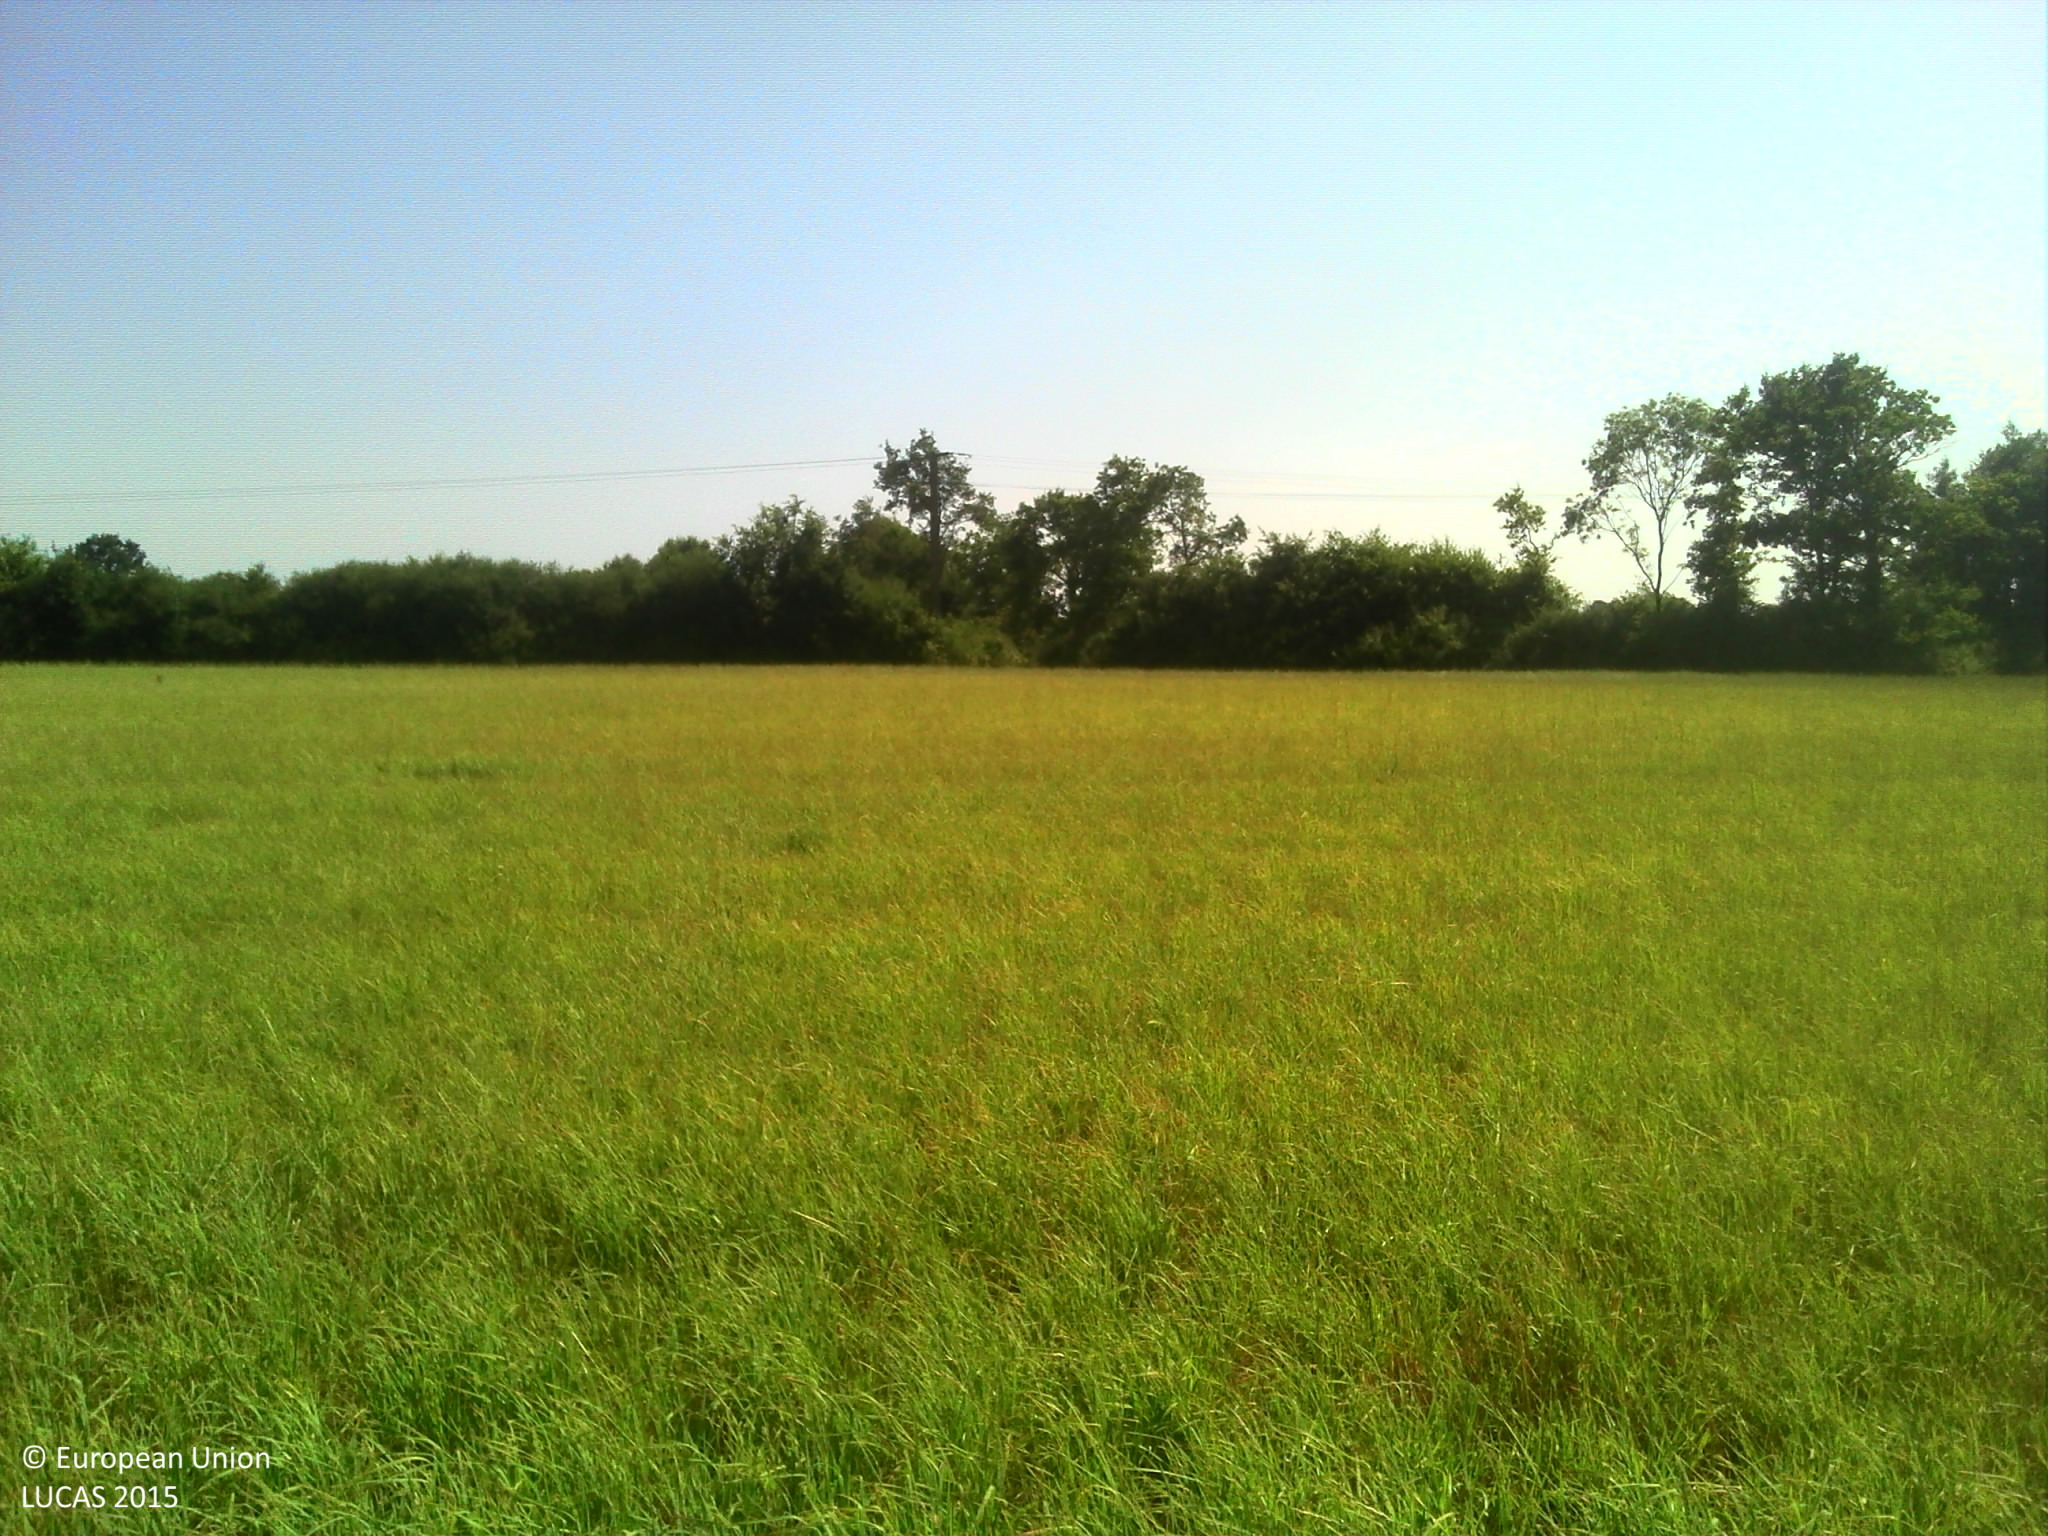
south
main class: Cropland
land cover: Temporary grasslands
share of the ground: > 75 %
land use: Agriculture (excluding fallow land and kitchen gardens)
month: July
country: FR
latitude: 46.5450
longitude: -1.6860
